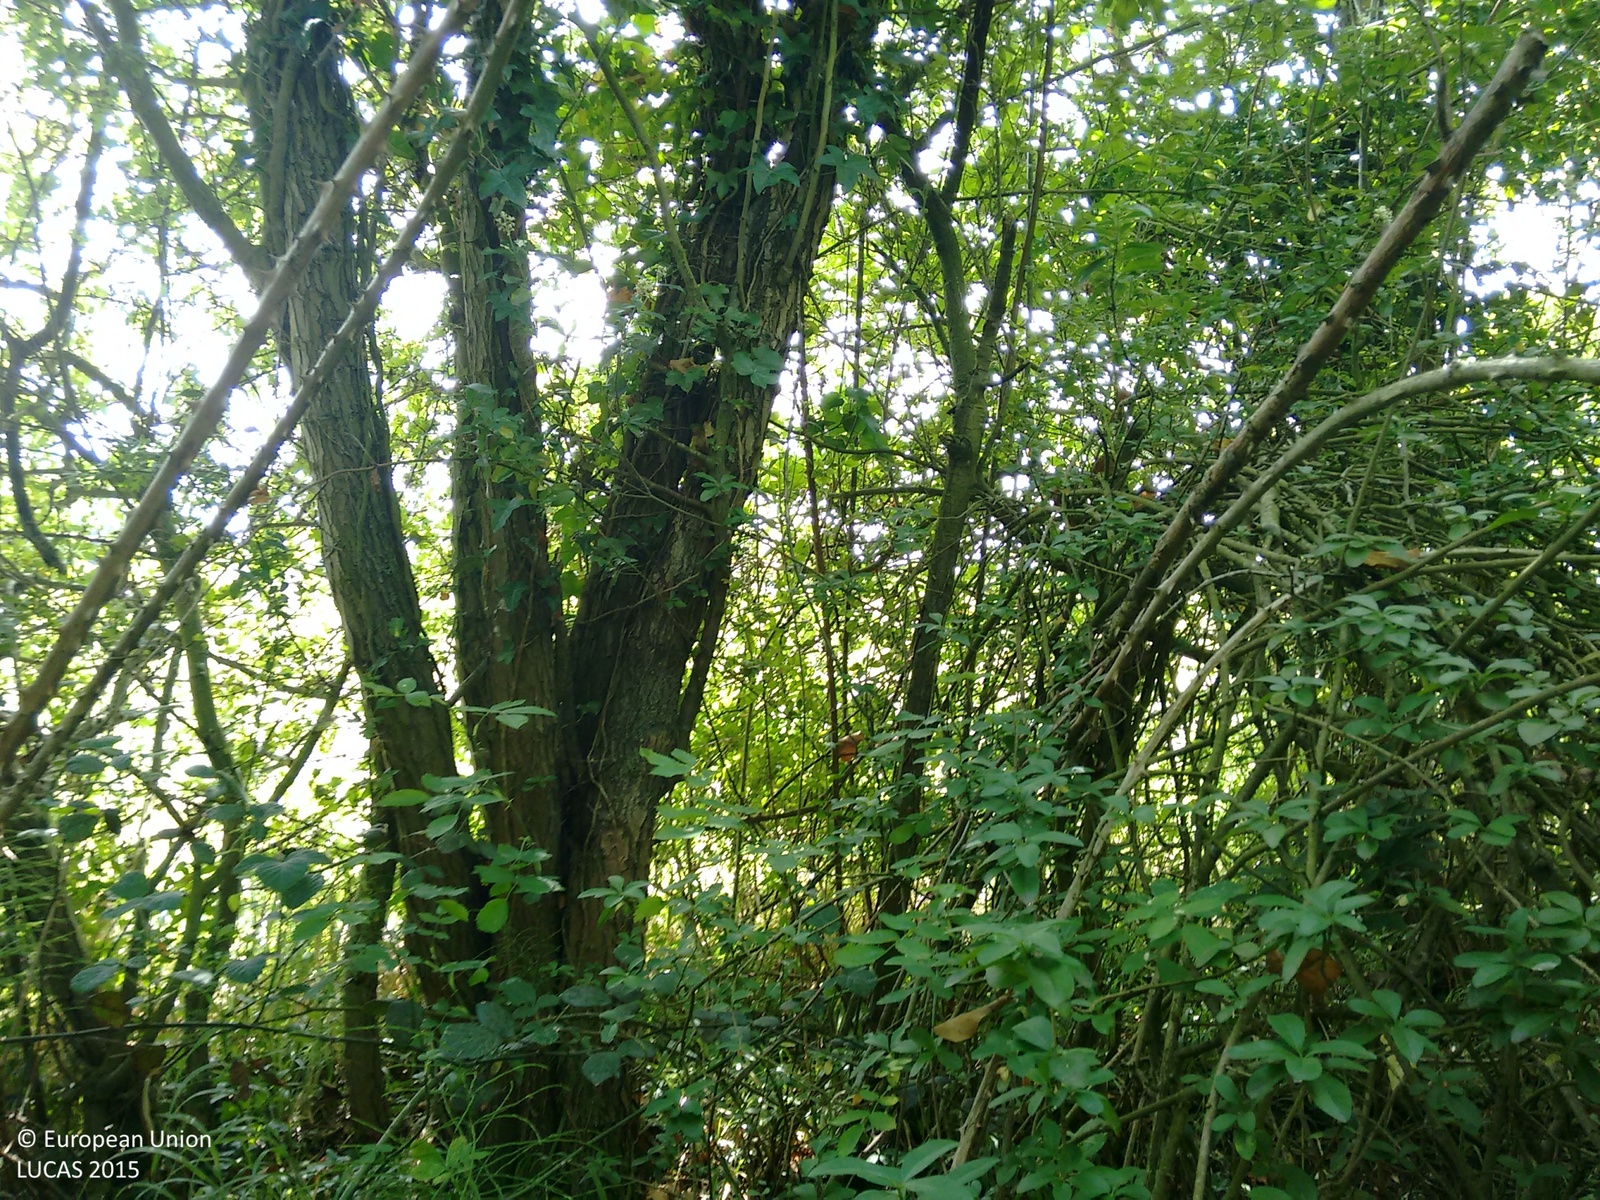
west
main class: Woodland
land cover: Broadleaved woodland
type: mesophytic deciduous forest
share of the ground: > 75 %
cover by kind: broadleaved forest trees 80 %, shrubs 10 %, herbaceous plants 10 %
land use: Semi-natural and natural areas not in use
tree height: > 5 m
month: July
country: GB
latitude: 51.6373
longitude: -1.0993
